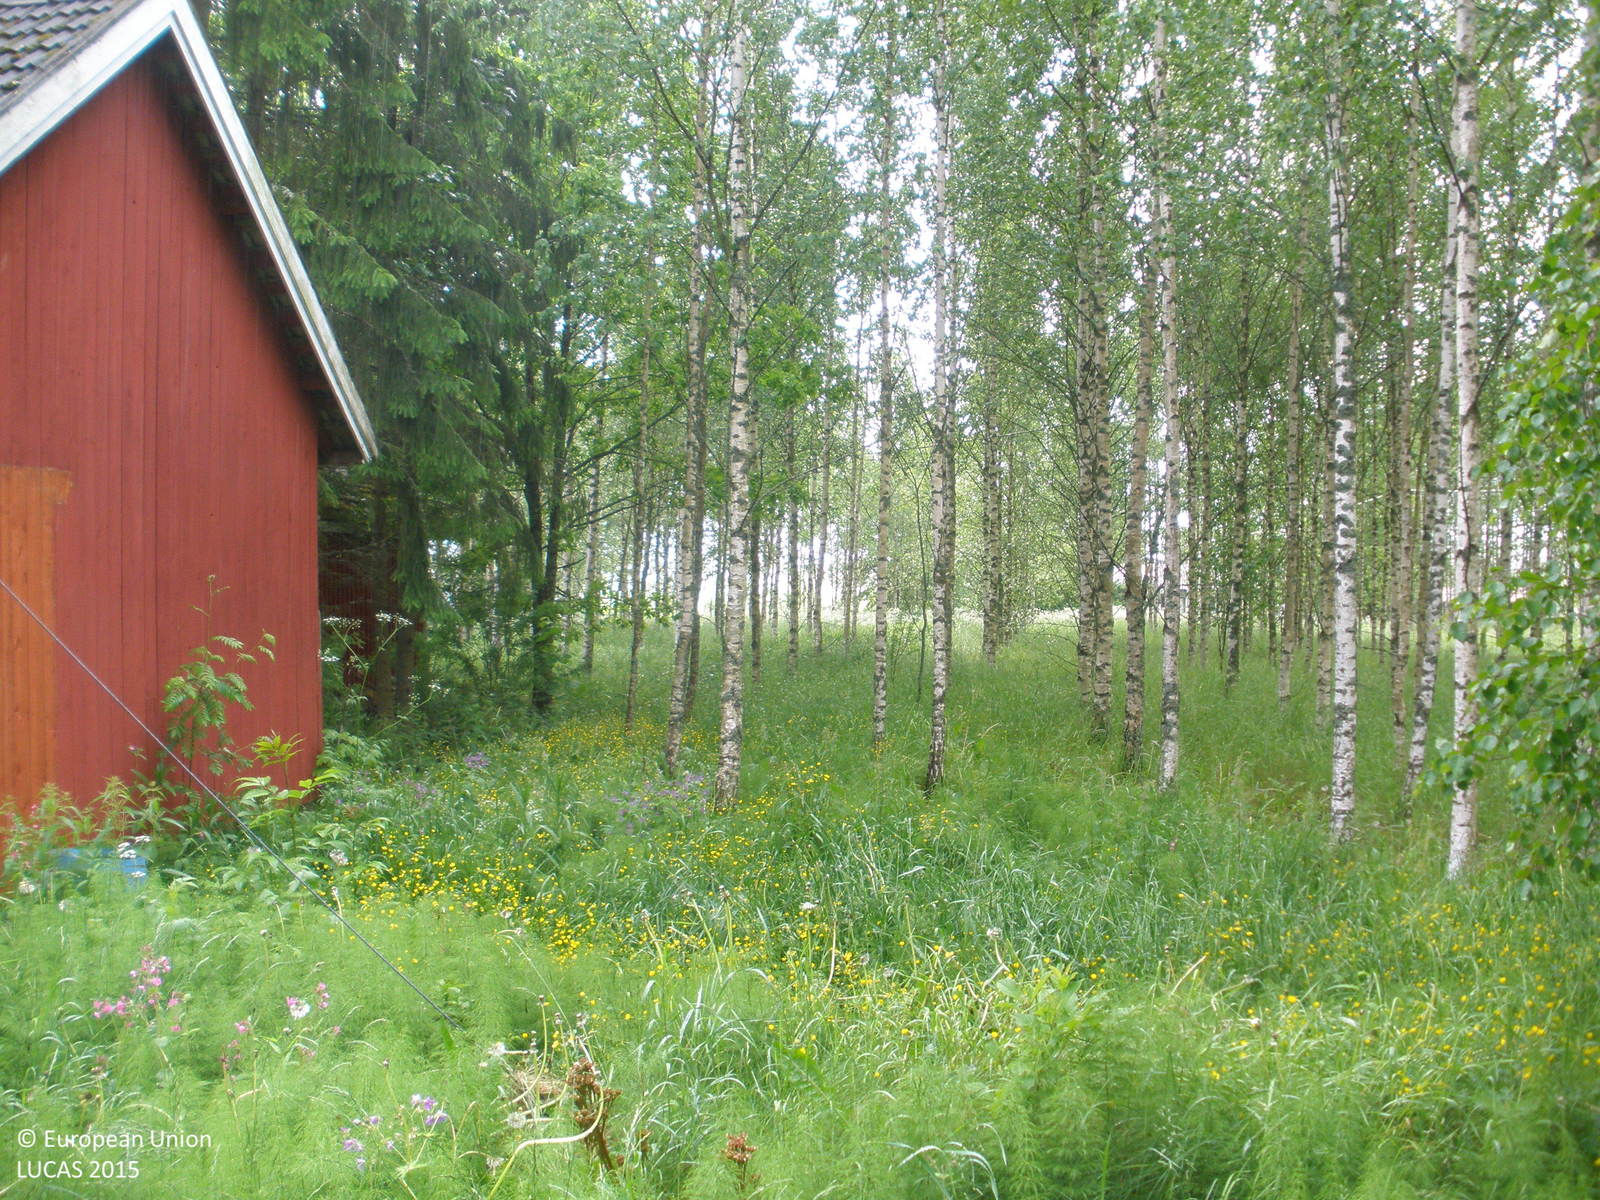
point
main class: Woodland
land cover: Broadleaved woodland
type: non-riverine alder, birch or aspen forest
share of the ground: > 75 %
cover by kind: broadleaved forest trees 80 %, herbaceous plants 15 %, shrubs 5 %
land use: Forestry
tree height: > 5 m
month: June
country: FI
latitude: 60.8847
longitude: 23.4779
